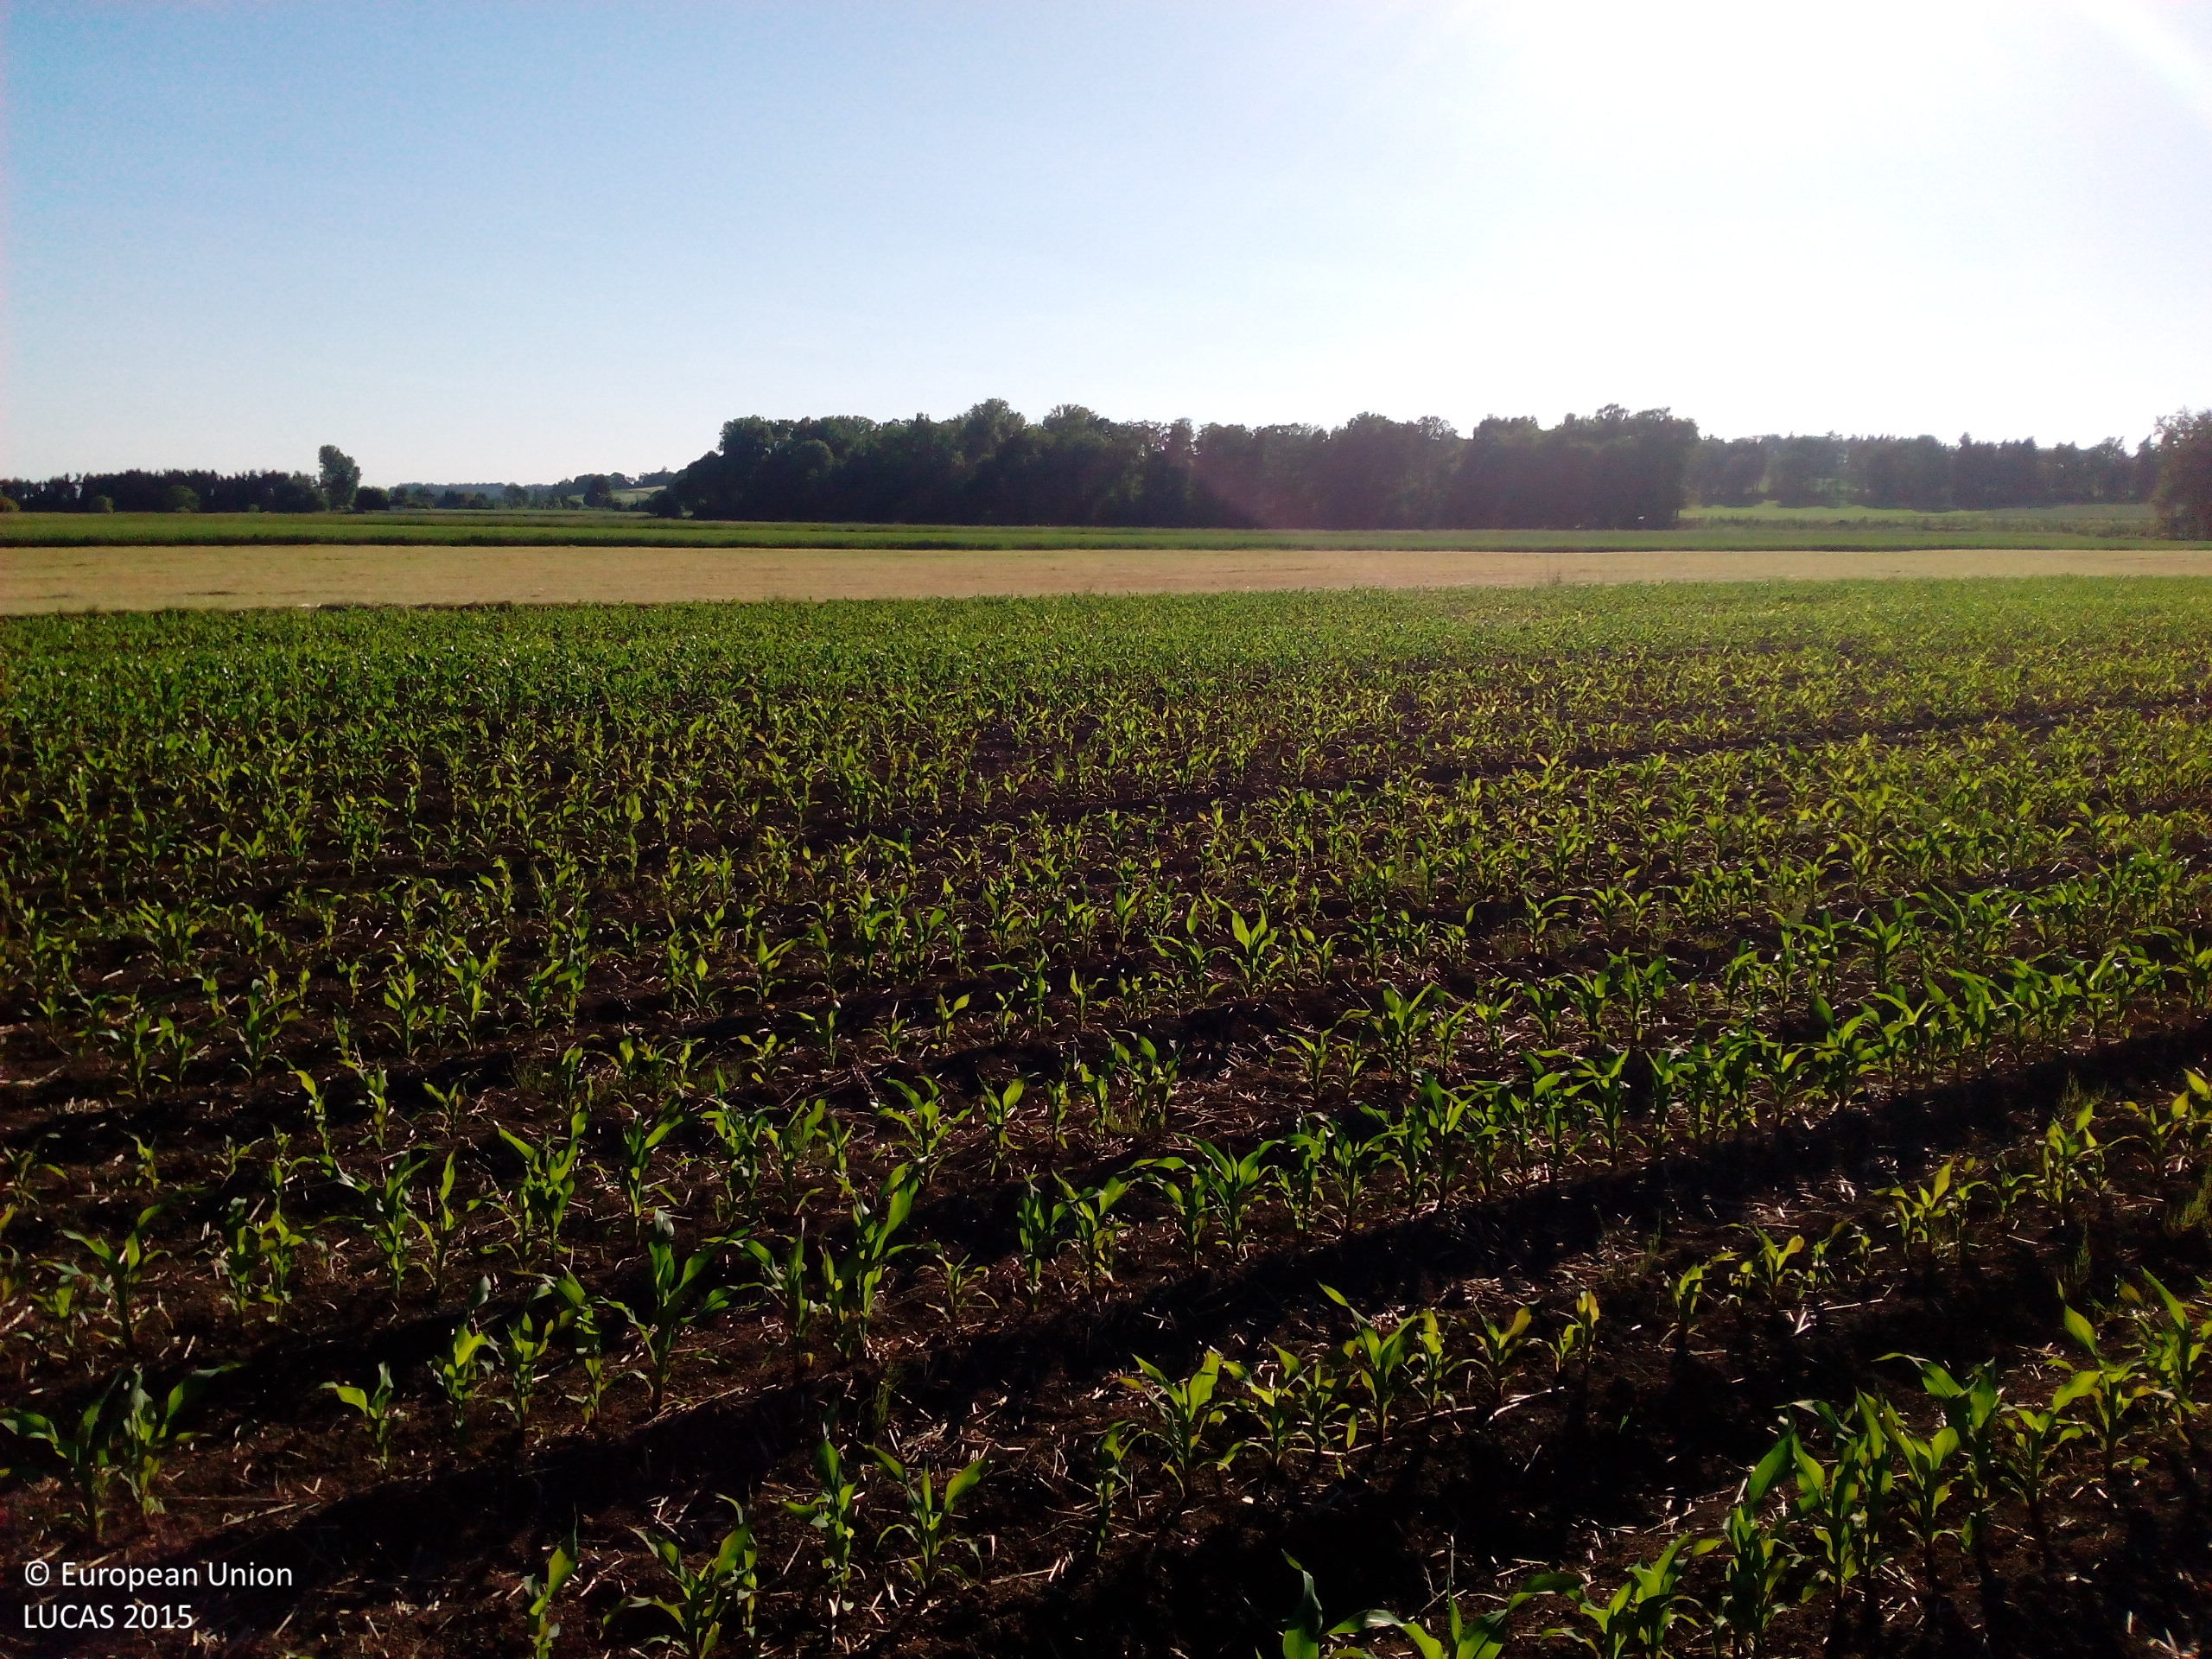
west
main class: Cropland
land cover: Maize
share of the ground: < 10 %
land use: Agriculture (excluding fallow land and kitchen gardens)
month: June
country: DE
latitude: 48.8452
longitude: 12.4112
